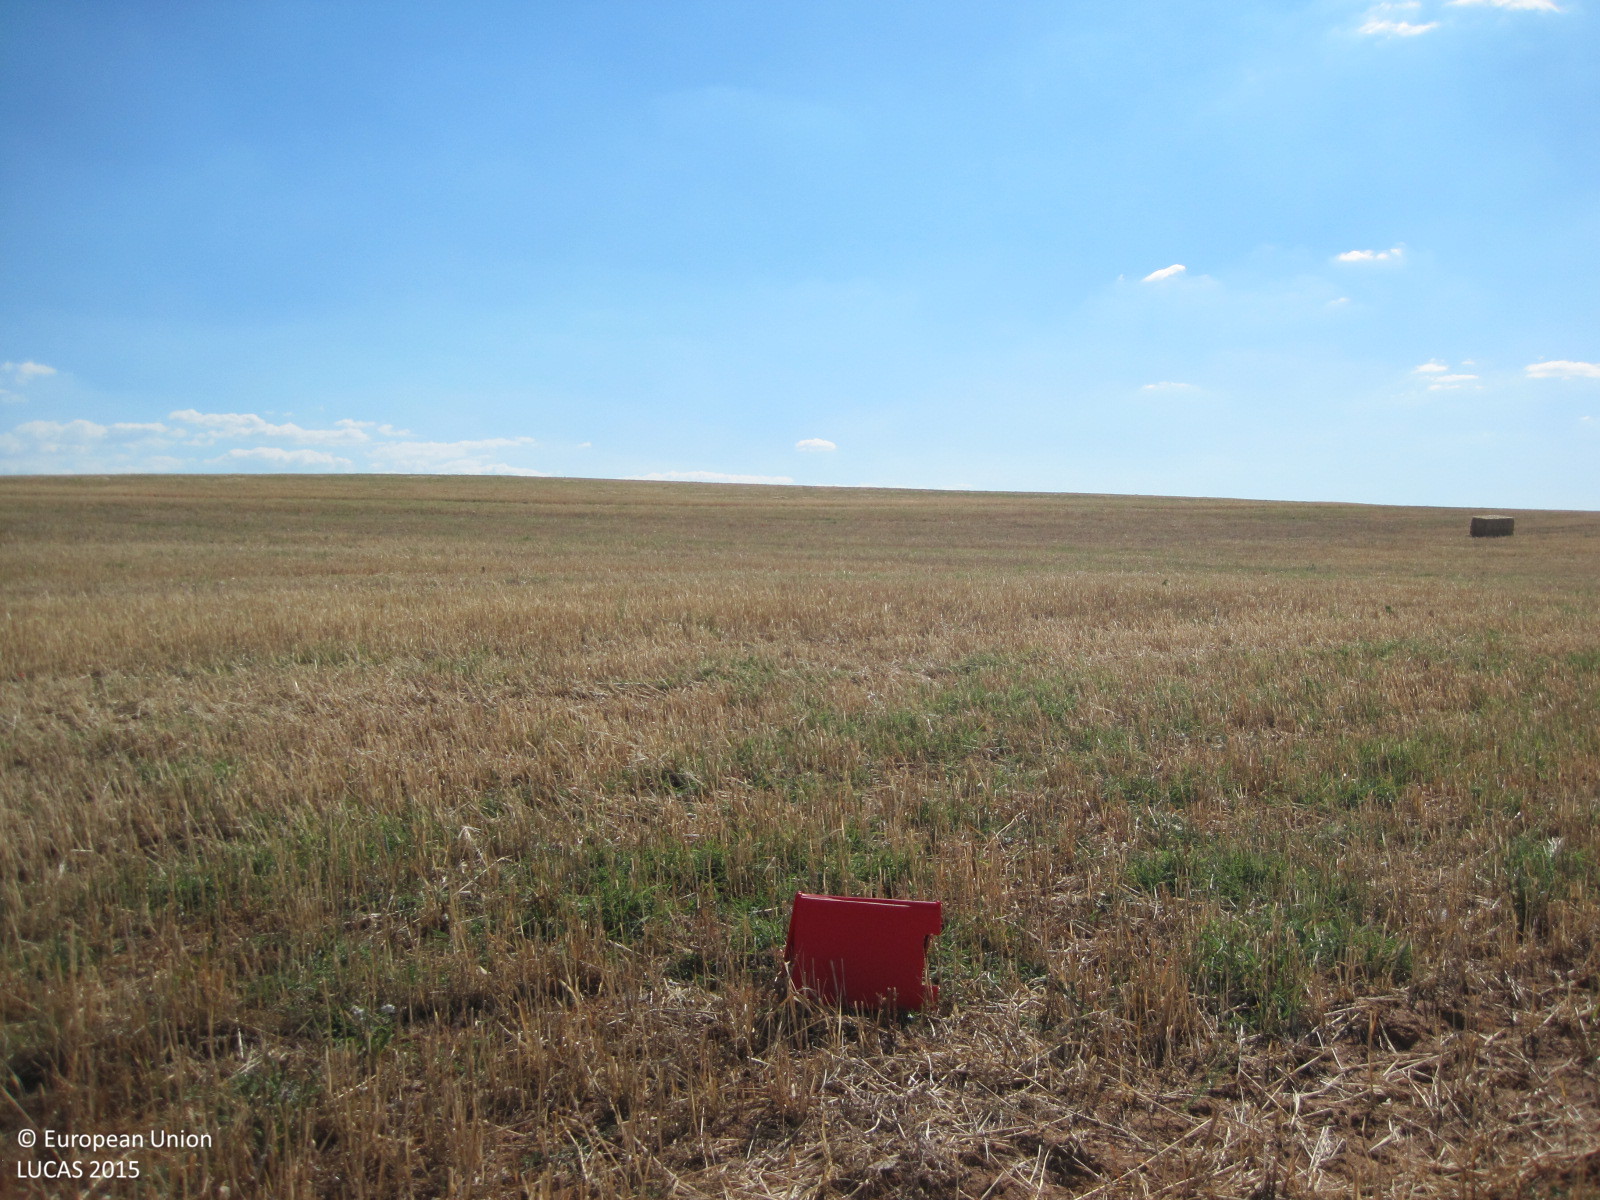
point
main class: Cropland
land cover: Barley
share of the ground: < 10 %
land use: Agriculture (excluding fallow land and kitchen gardens)
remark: Harvested field
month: June
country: ES
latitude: 39.9245
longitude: -4.2070
